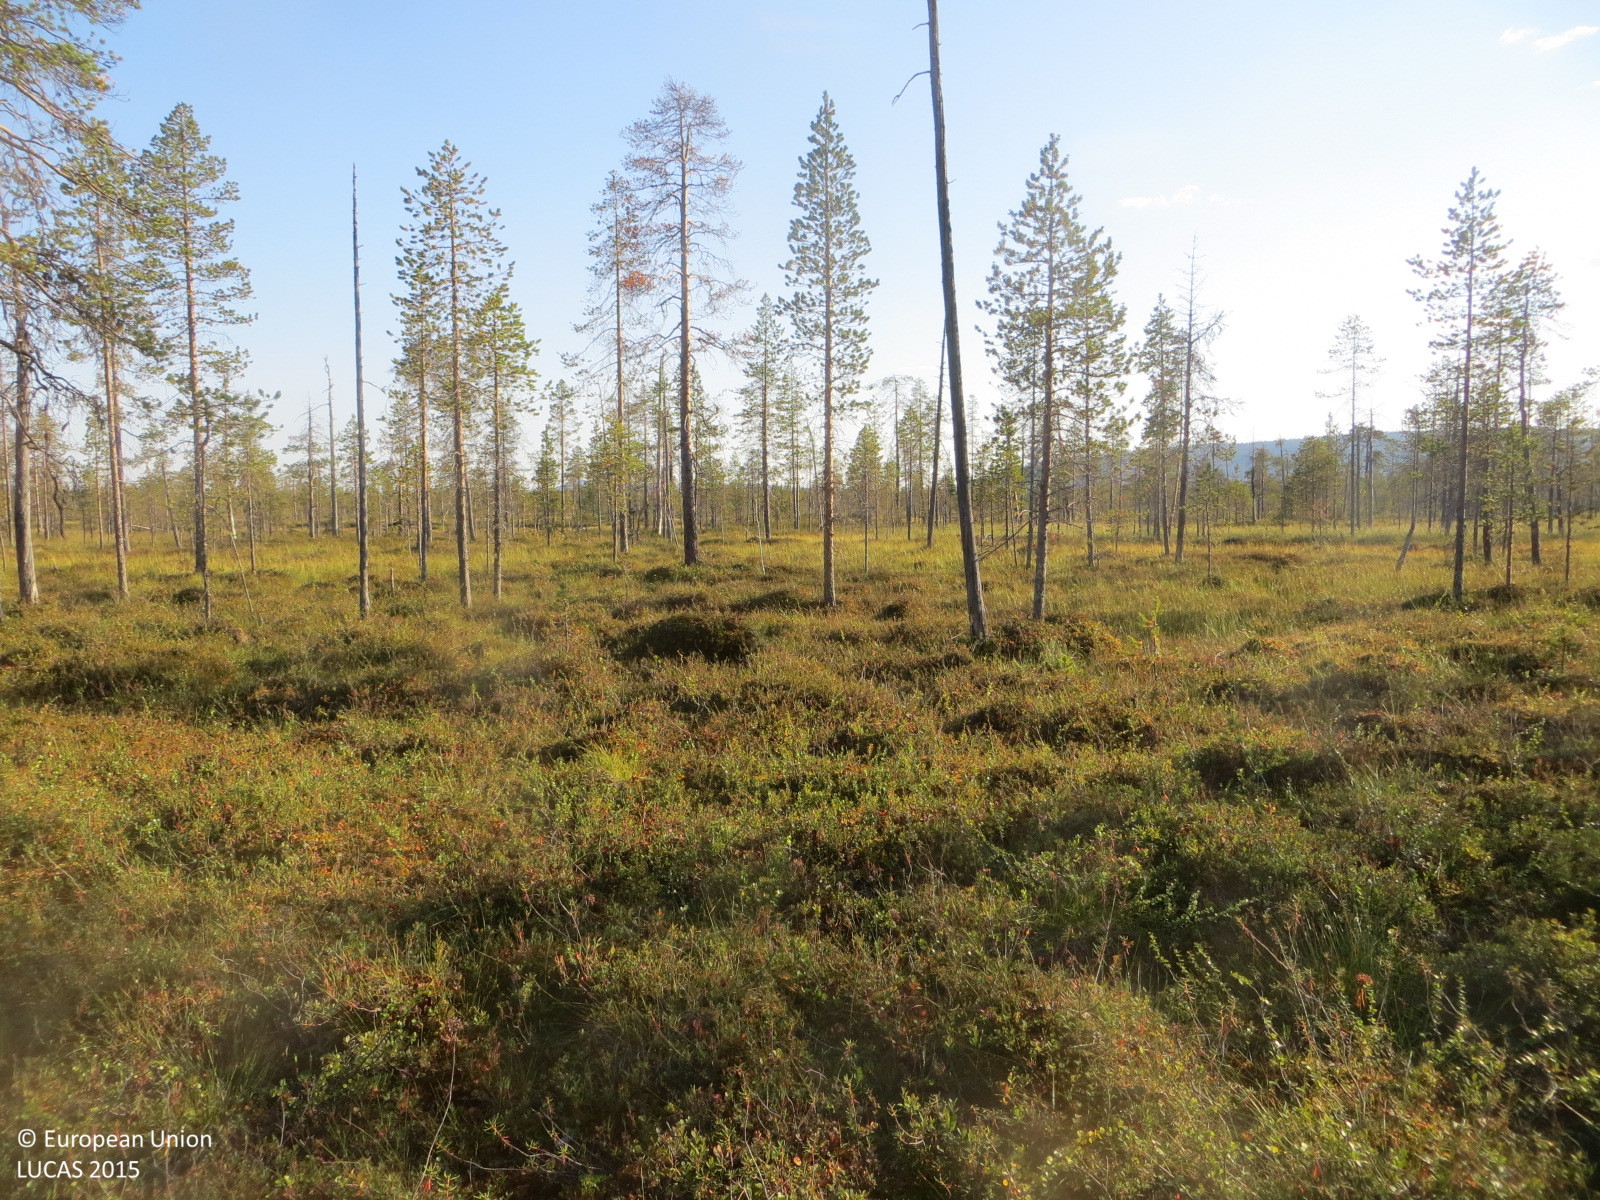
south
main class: Woodland
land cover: Pine dominated coniferous woodland
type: mire and swamp forests
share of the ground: 10 - 25 %
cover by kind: shrubs 60 %, coniferous forest trees 20 %, herbaceous plants 20 %
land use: Amenities, museums, leisure
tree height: > 5 m
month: August
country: FI
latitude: 67.7876
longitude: 24.3169
